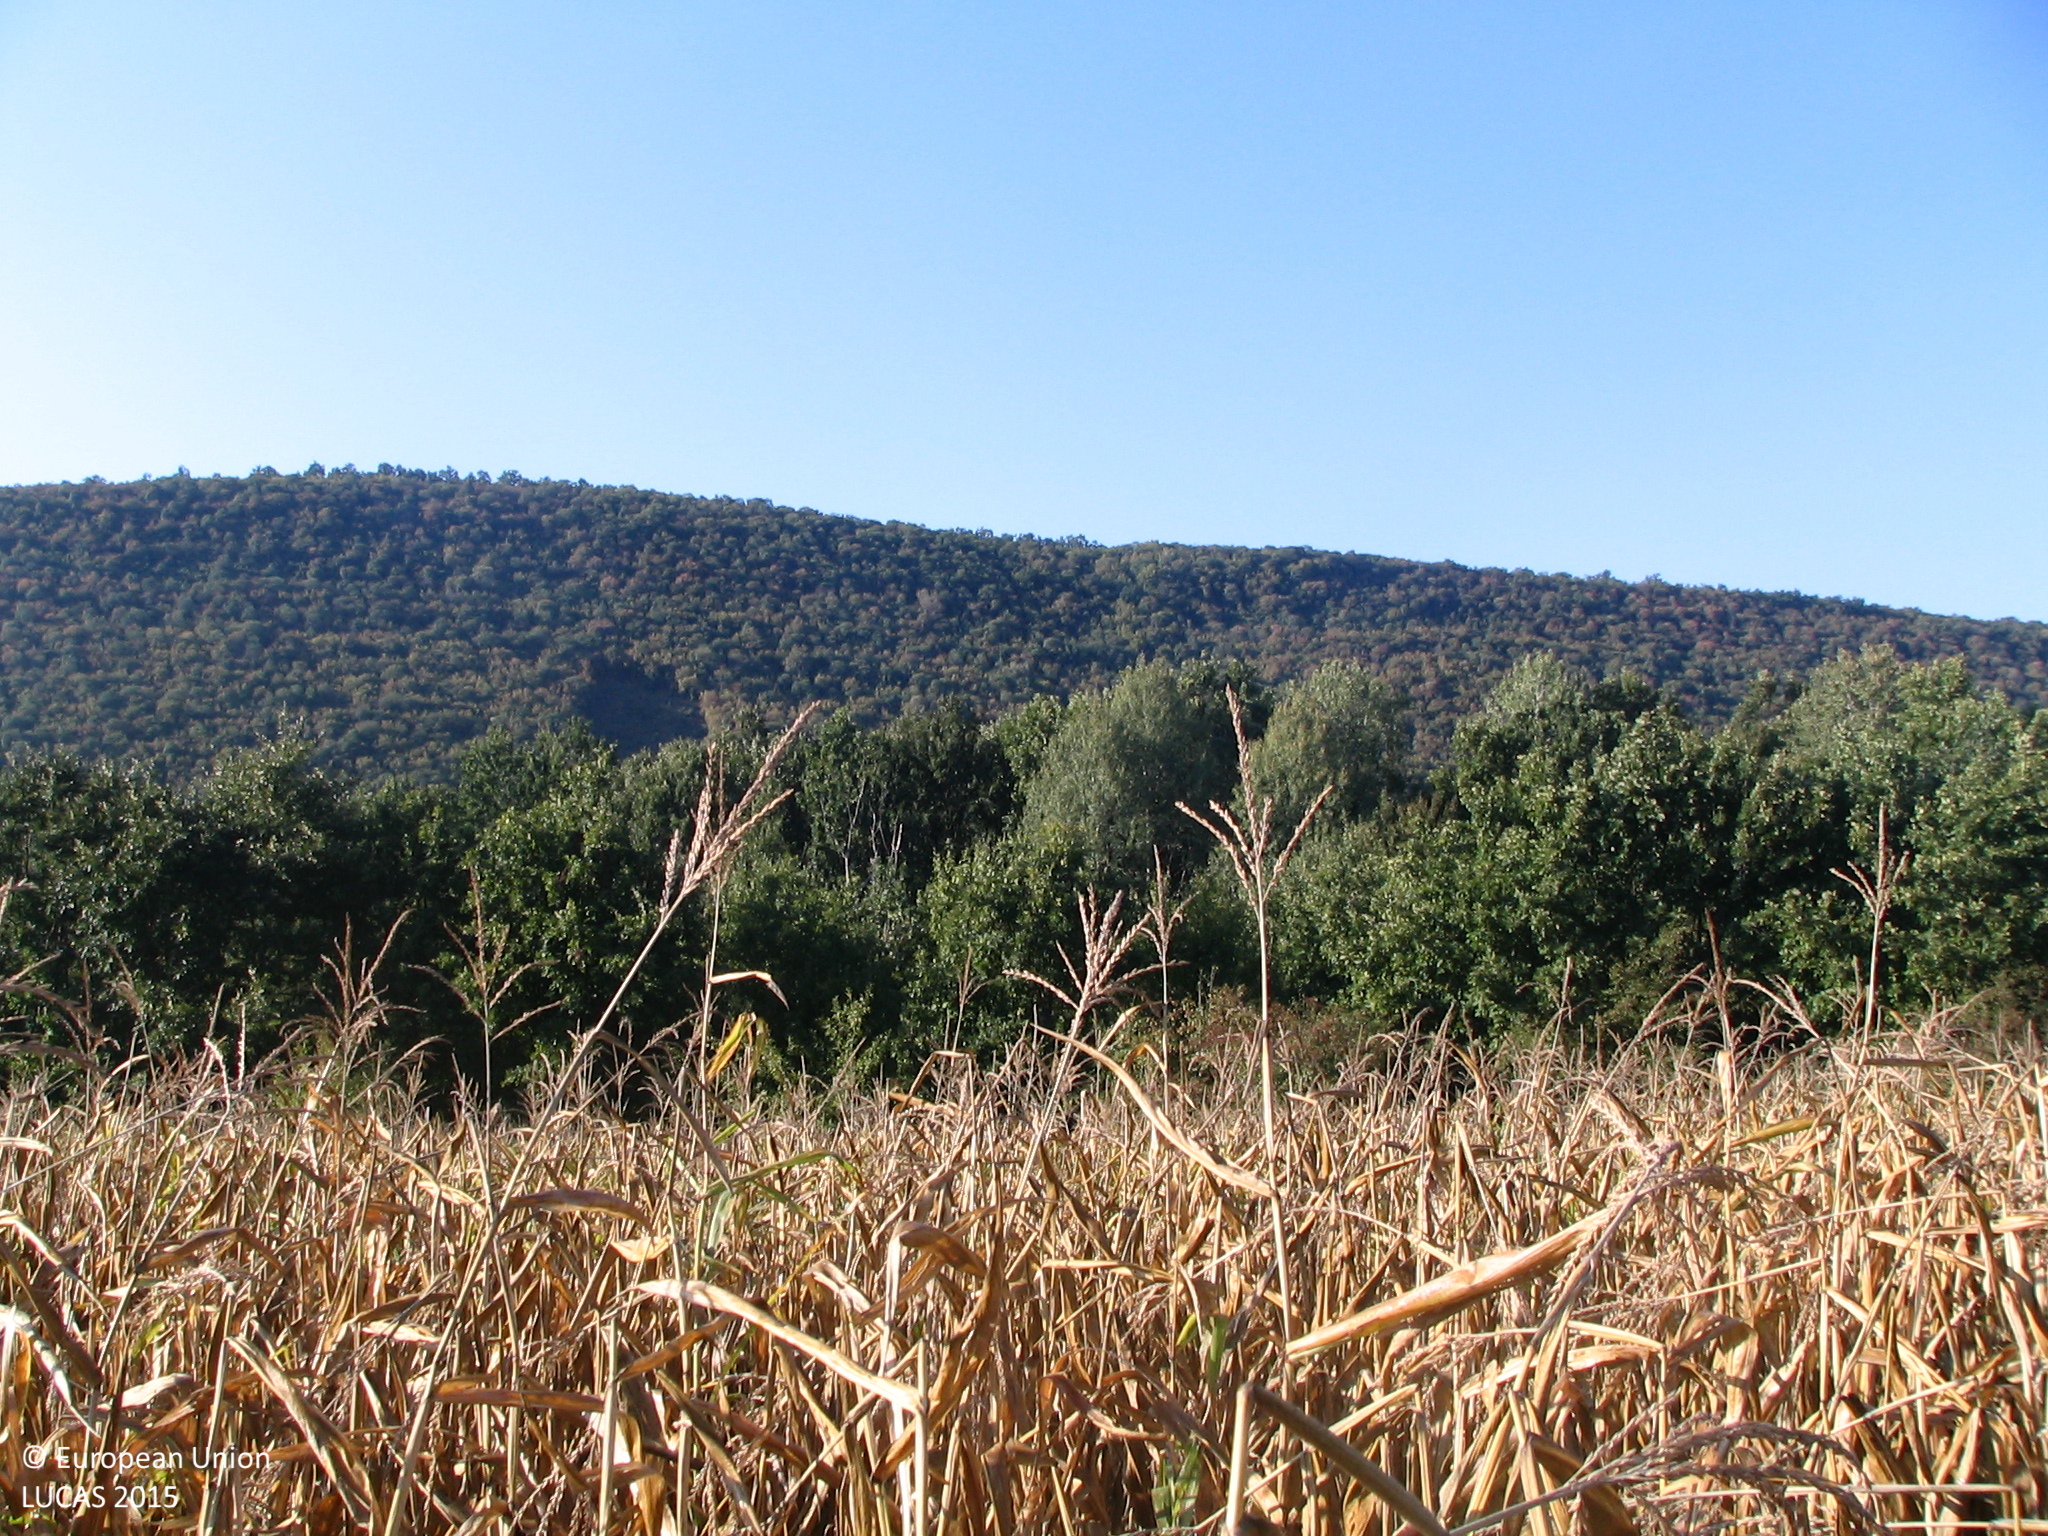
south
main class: Cropland
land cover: Maize
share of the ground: > 75 %
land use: Agriculture (excluding fallow land and kitchen gardens)
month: August
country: BG
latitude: 43.0606
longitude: 24.4344
